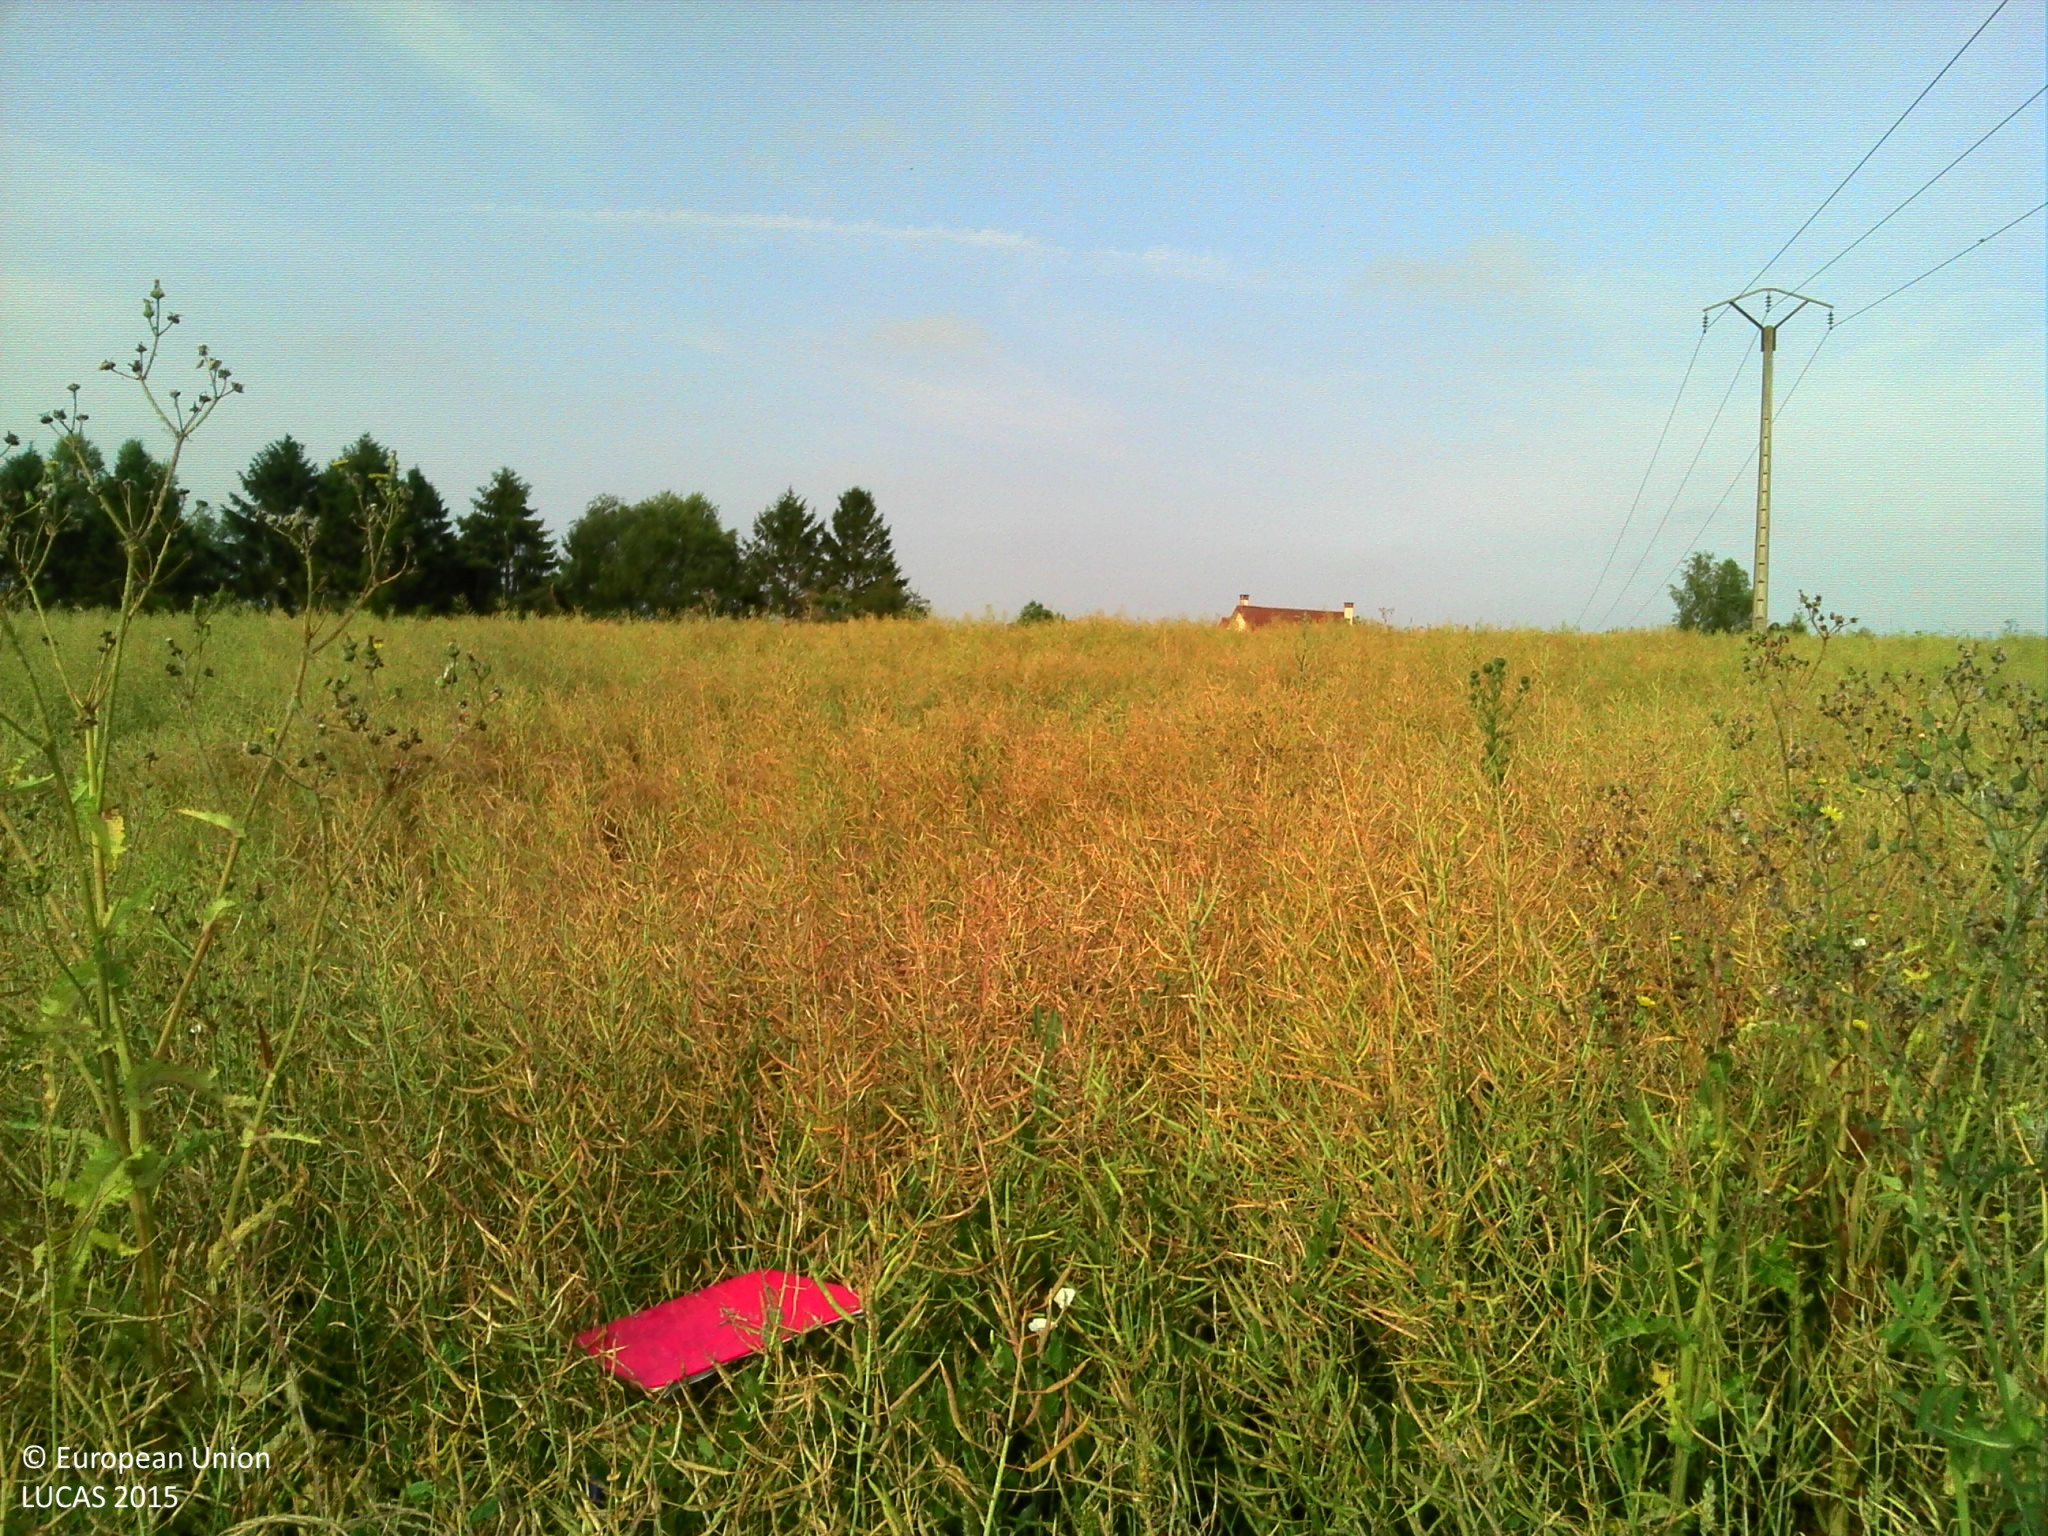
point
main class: Cropland
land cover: Rape and turnip rape
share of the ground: > 75 %
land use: Agriculture (excluding fallow land and kitchen gardens)
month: July
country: FR
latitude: 49.6058
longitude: 1.8890
